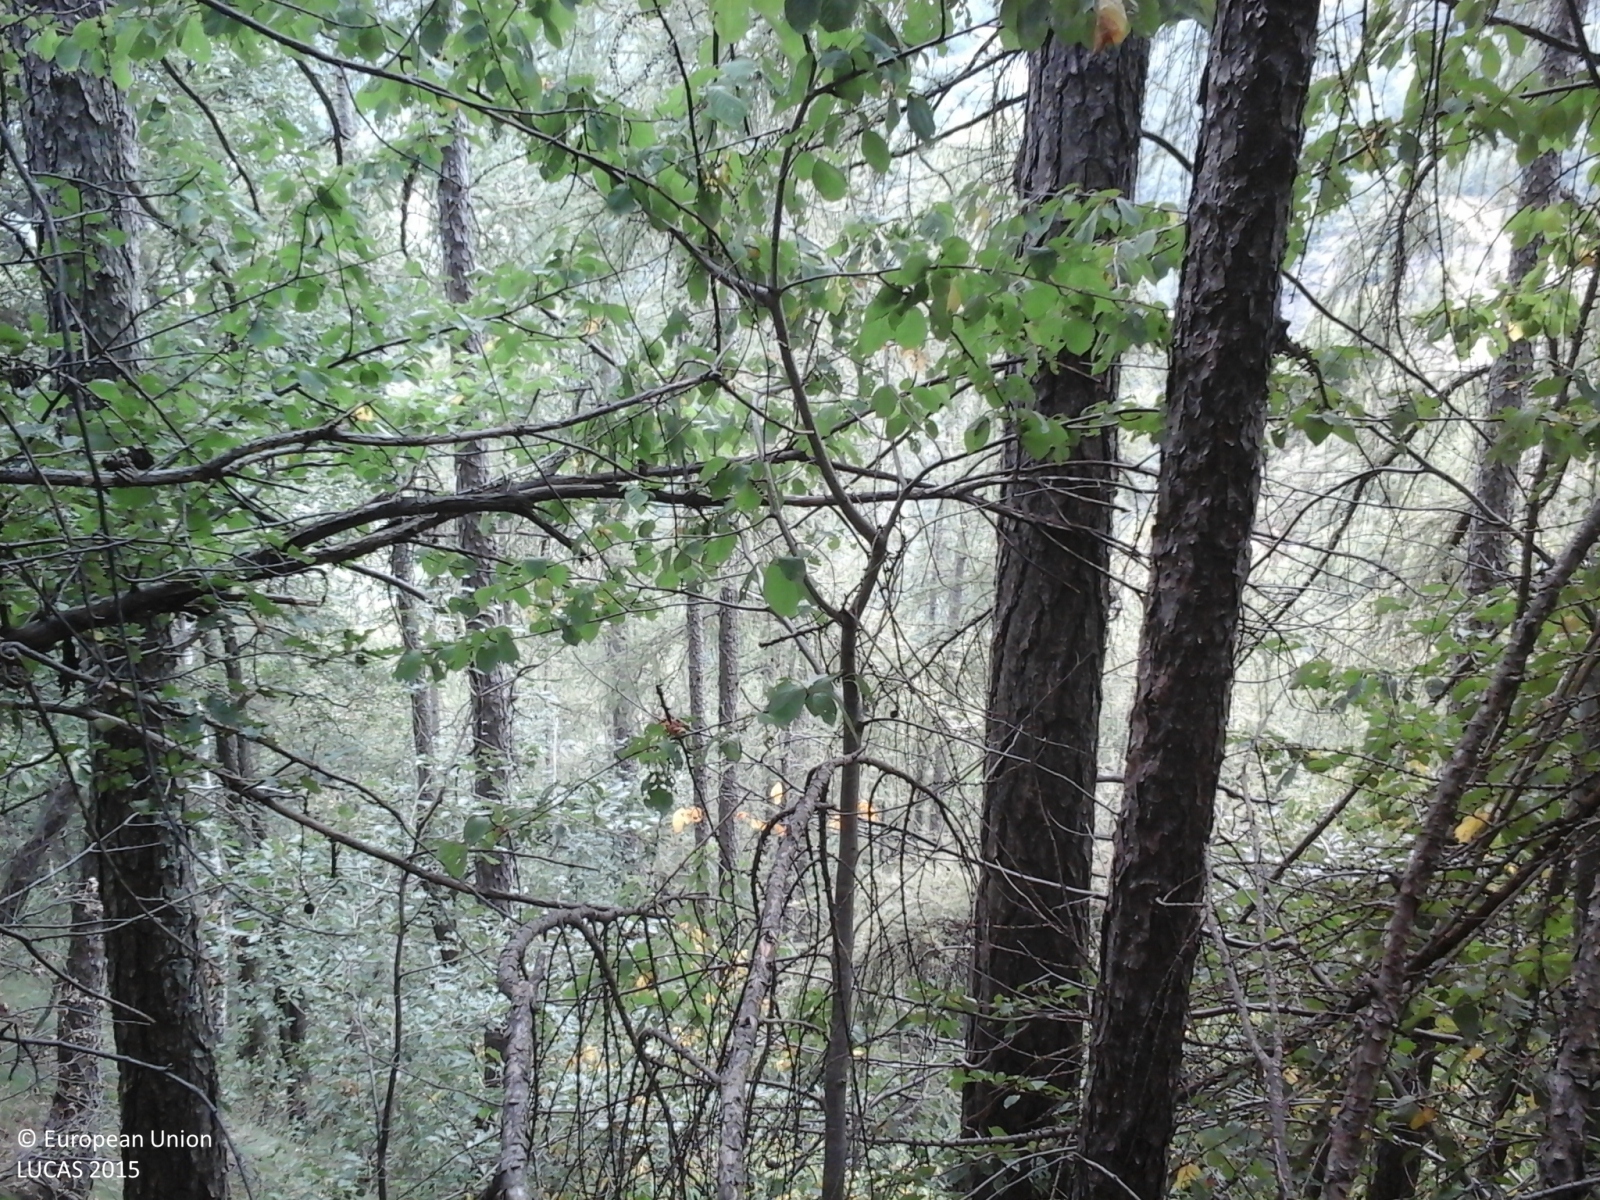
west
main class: Woodland
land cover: Broadleaved woodland
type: mesophytic deciduous forest
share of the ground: > 75 %
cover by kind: broadleaved forest trees 80 %, coniferous forest trees 20 %
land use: Semi-natural and natural areas not in use
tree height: > 5 m
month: August
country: IT
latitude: 45.6964
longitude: 7.7302
